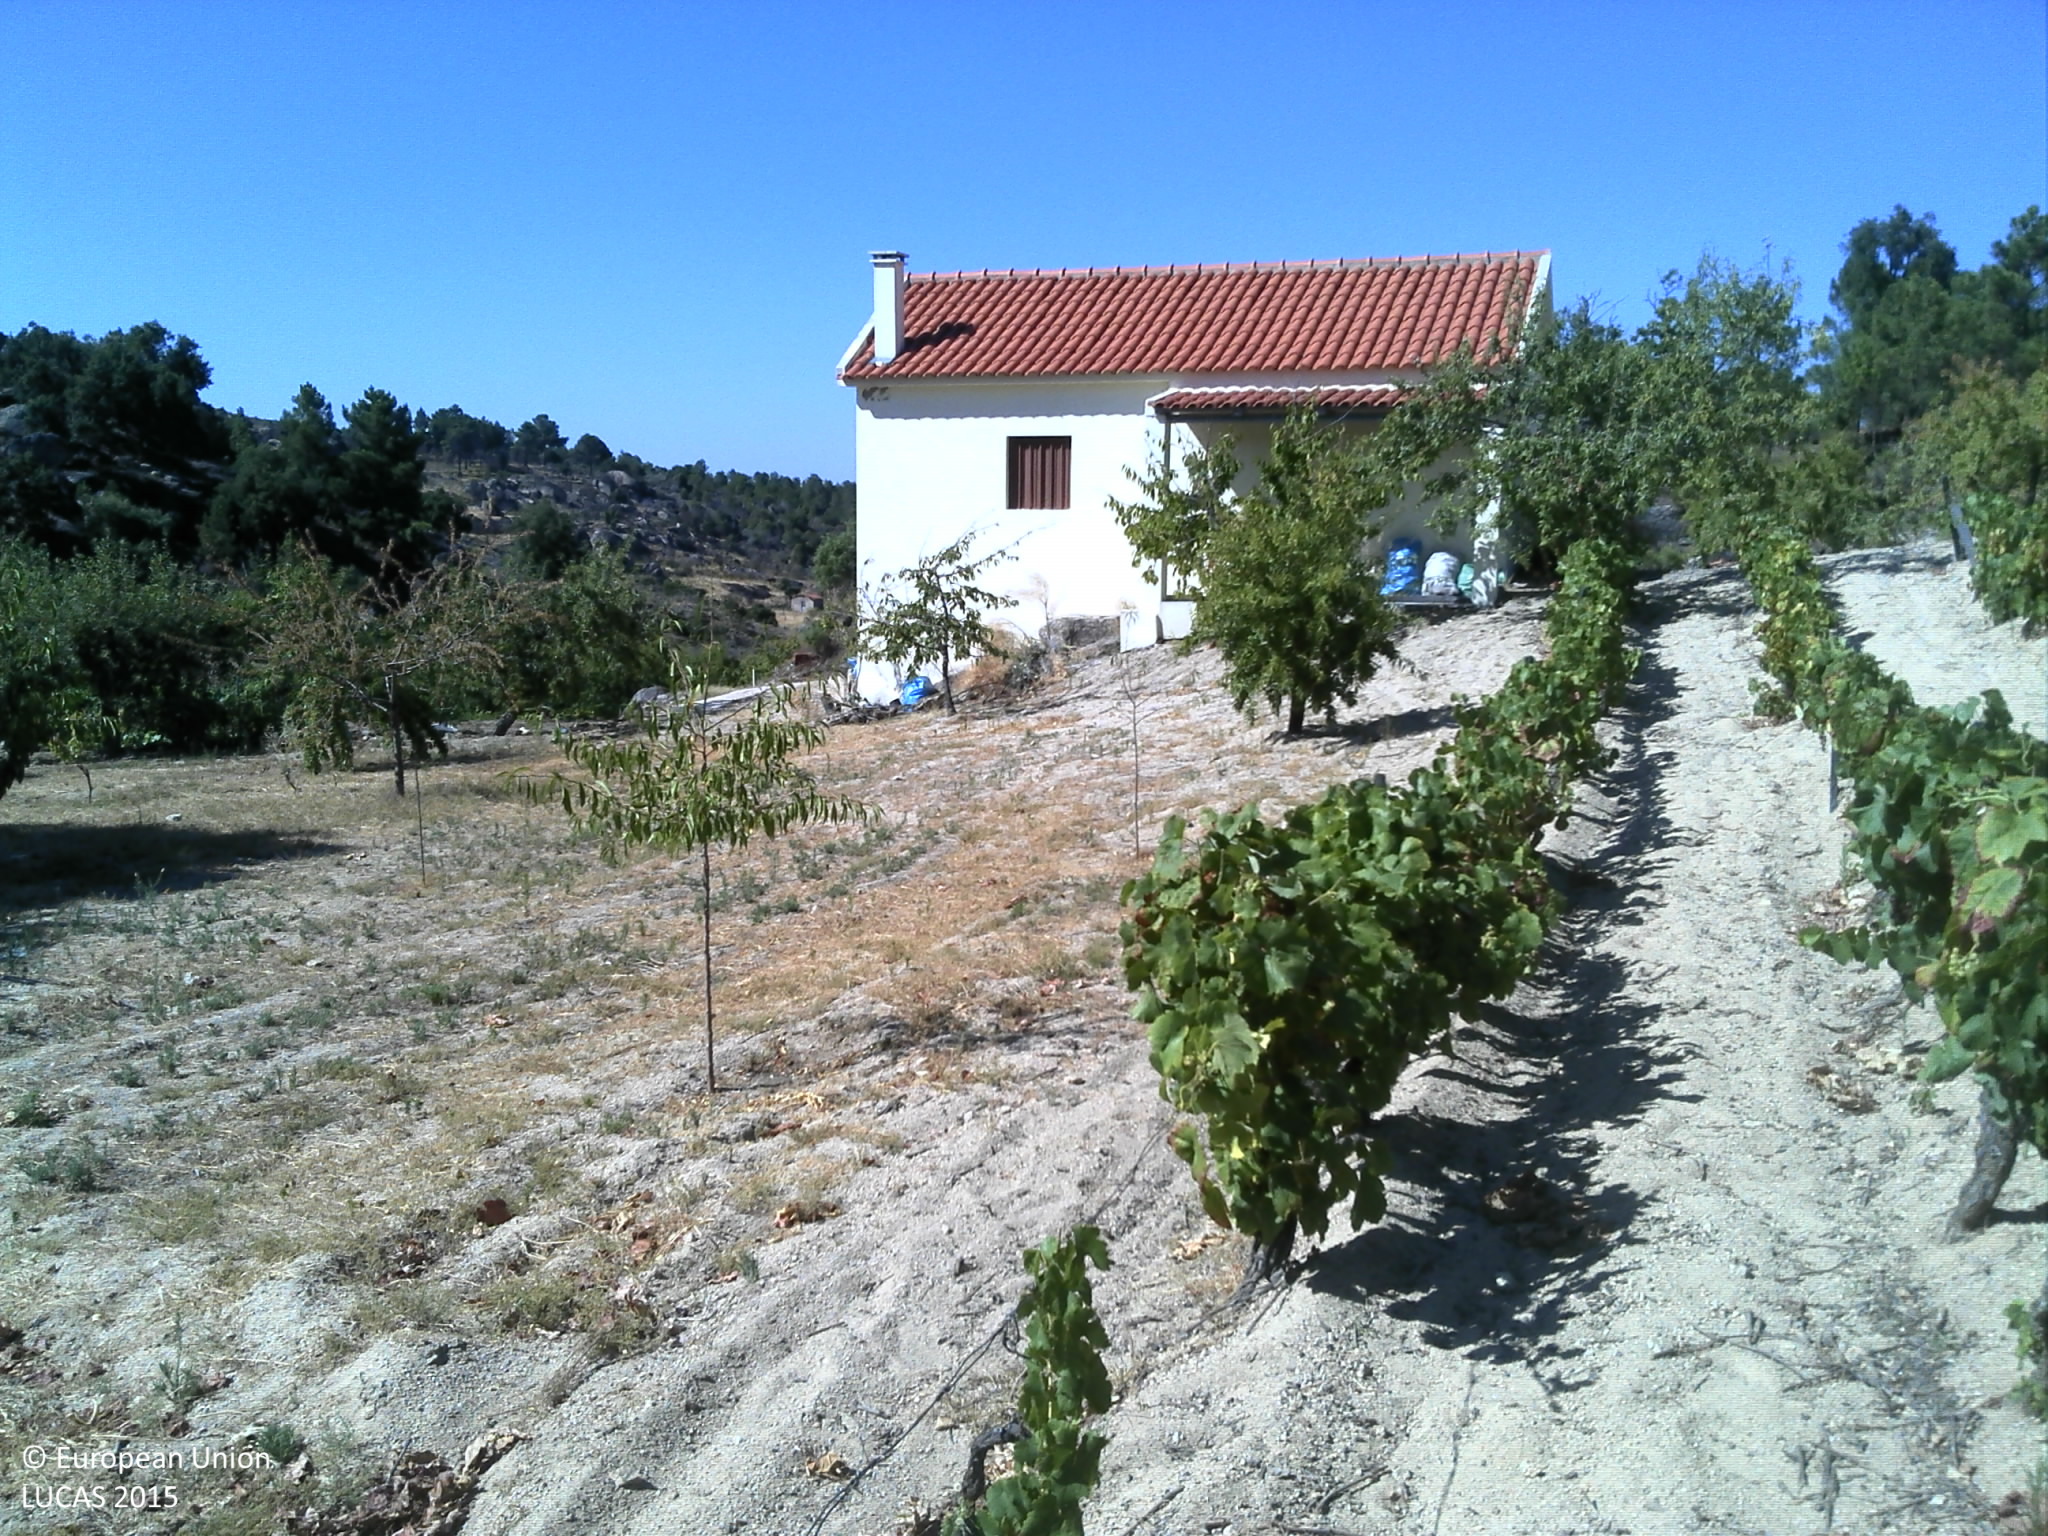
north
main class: Cropland
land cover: Vineyards
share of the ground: 10 - 25 %
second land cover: Other bare soil
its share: > 75 %
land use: Agriculture (excluding fallow land and kitchen gardens)
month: July
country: PT
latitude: 41.2841
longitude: -7.1777
